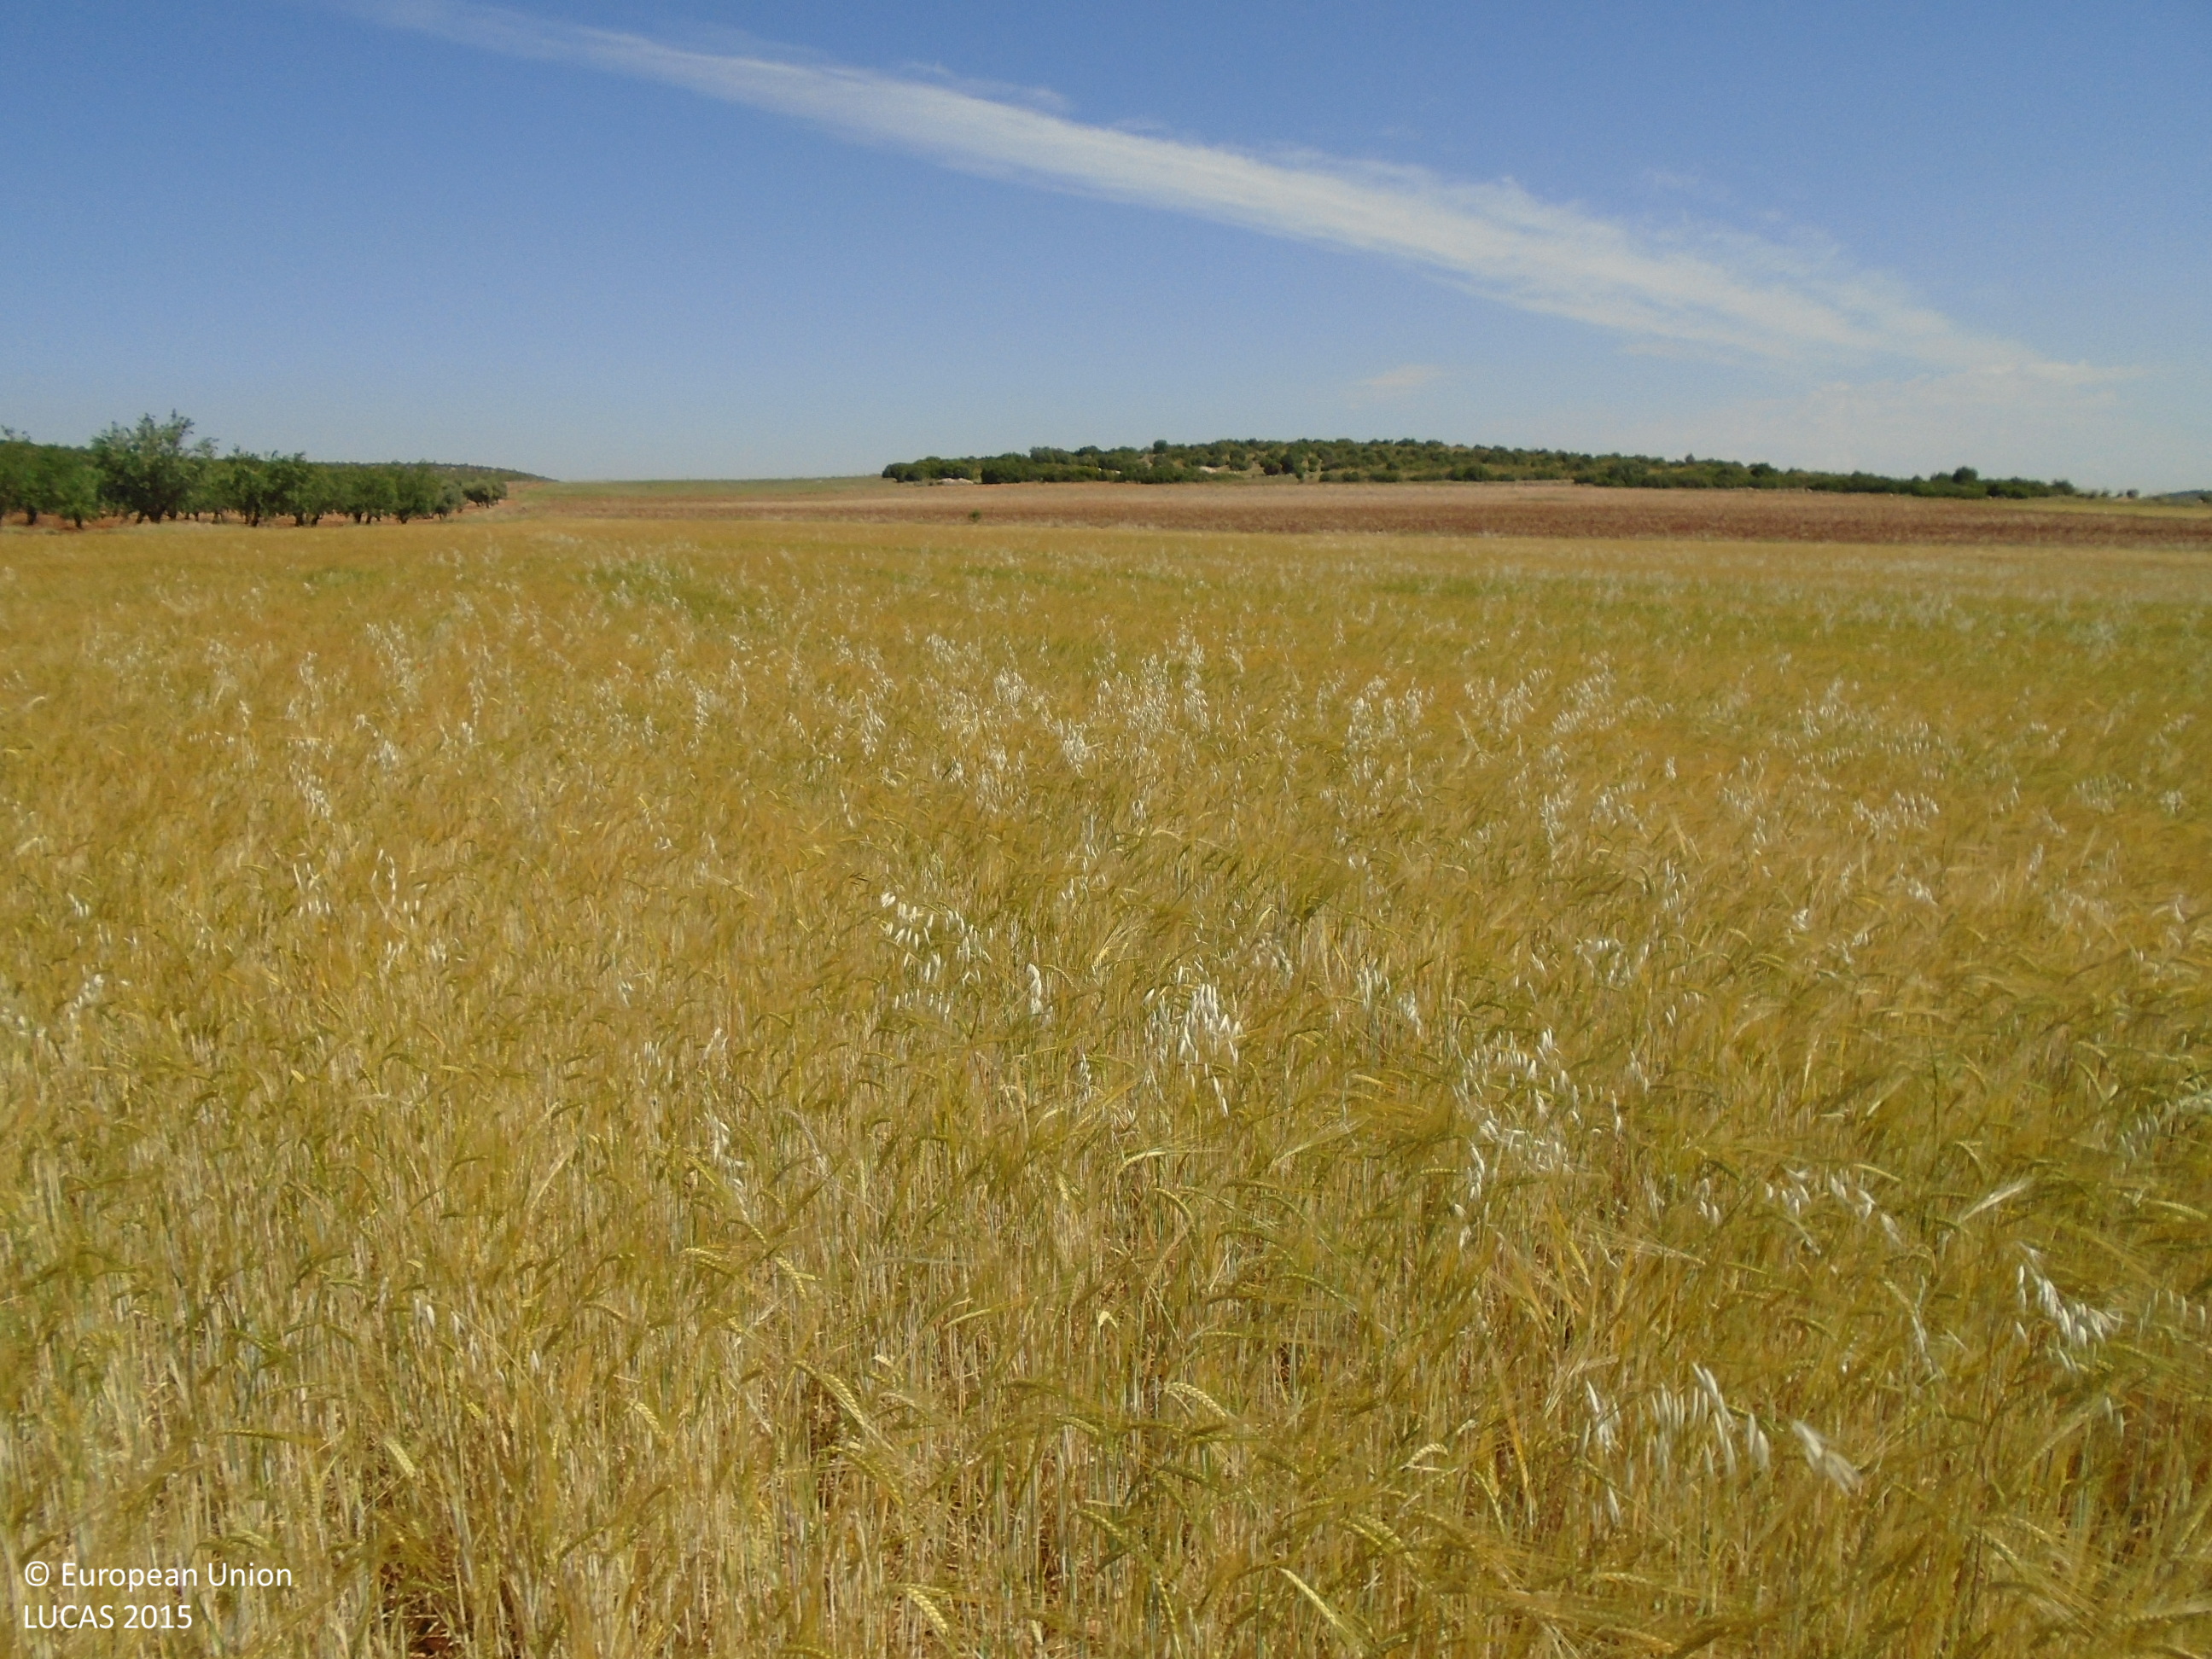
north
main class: Cropland
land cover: Barley
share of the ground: > 75 %
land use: Agriculture (excluding fallow land and kitchen gardens)
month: May
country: ES
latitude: 39.5511
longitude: -3.7470
